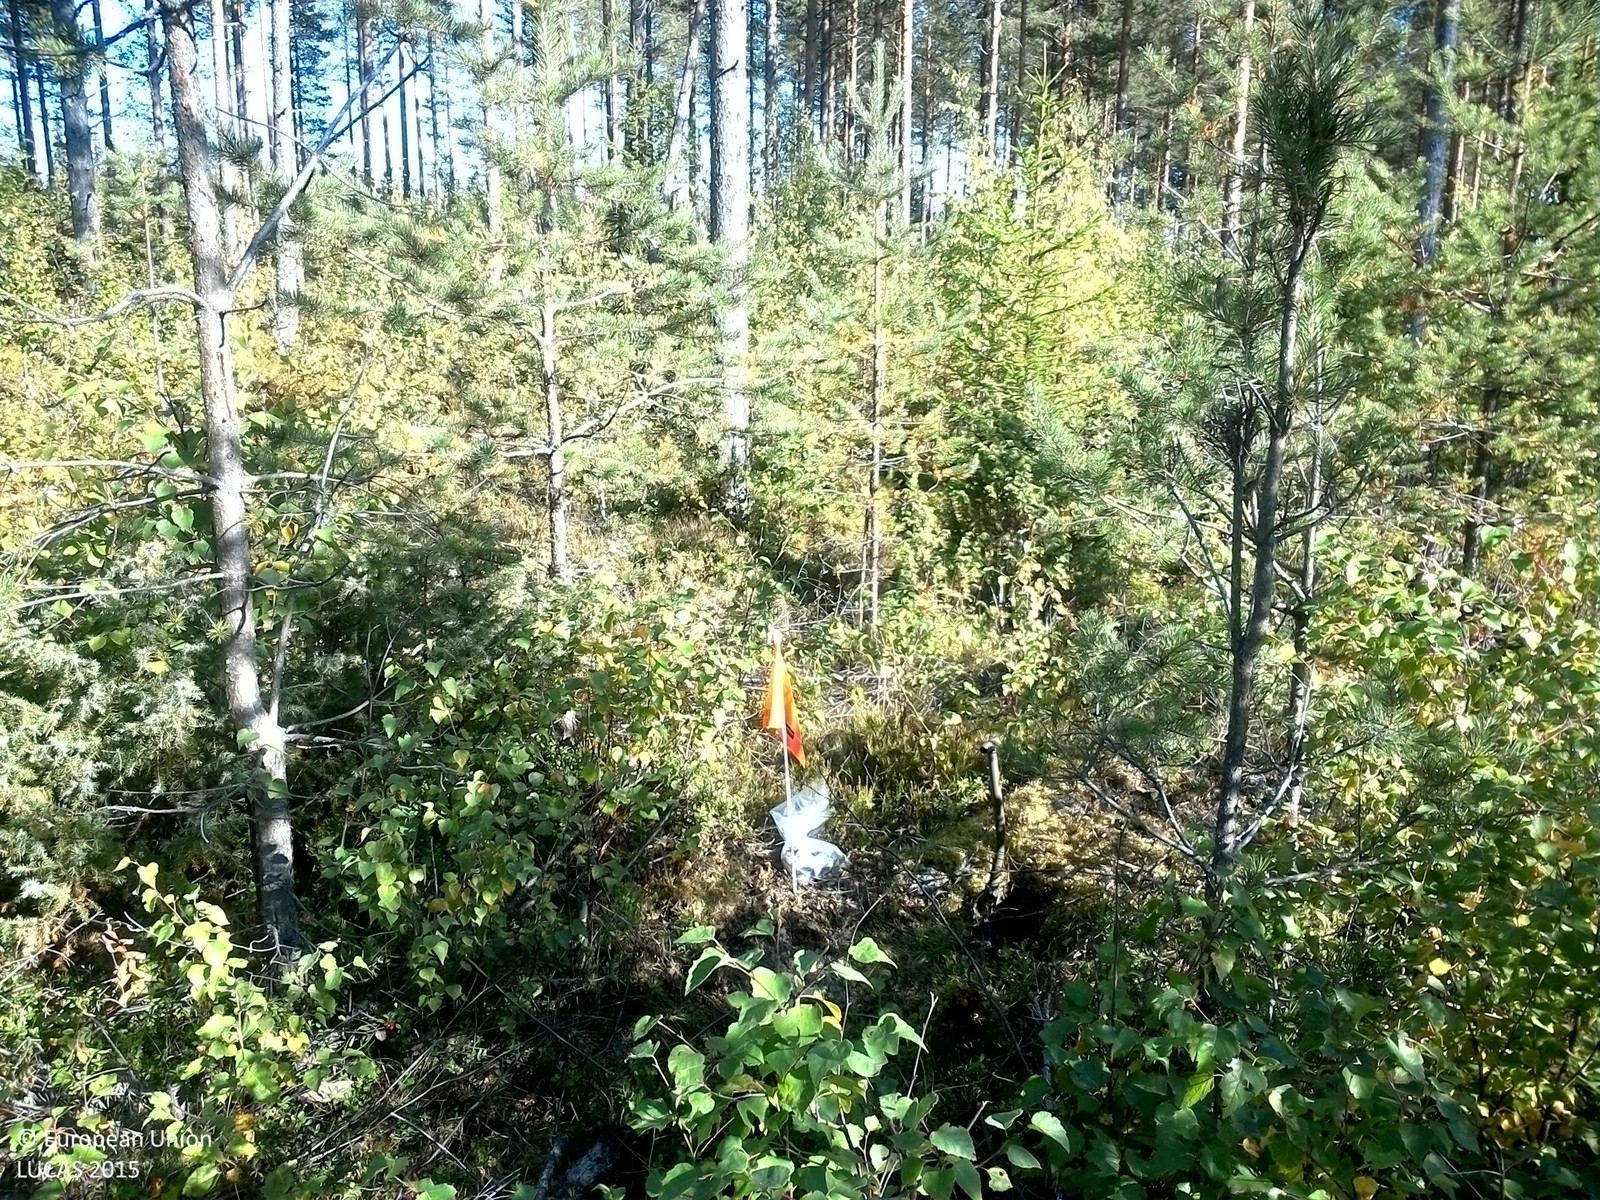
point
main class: Woodland
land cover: Pine dominated mixed woodland
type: boreal forest
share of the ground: 50 - 75 %
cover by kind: coniferous forest trees 35 %, shrubs 30 %, broadleaved forest trees 15 %, herbaceous plants 10 %, lichens and mosses 10 %
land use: Forestry
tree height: > 5 m
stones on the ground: 10 - 25 %
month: September
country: SE
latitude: 61.7718
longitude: 14.9678
